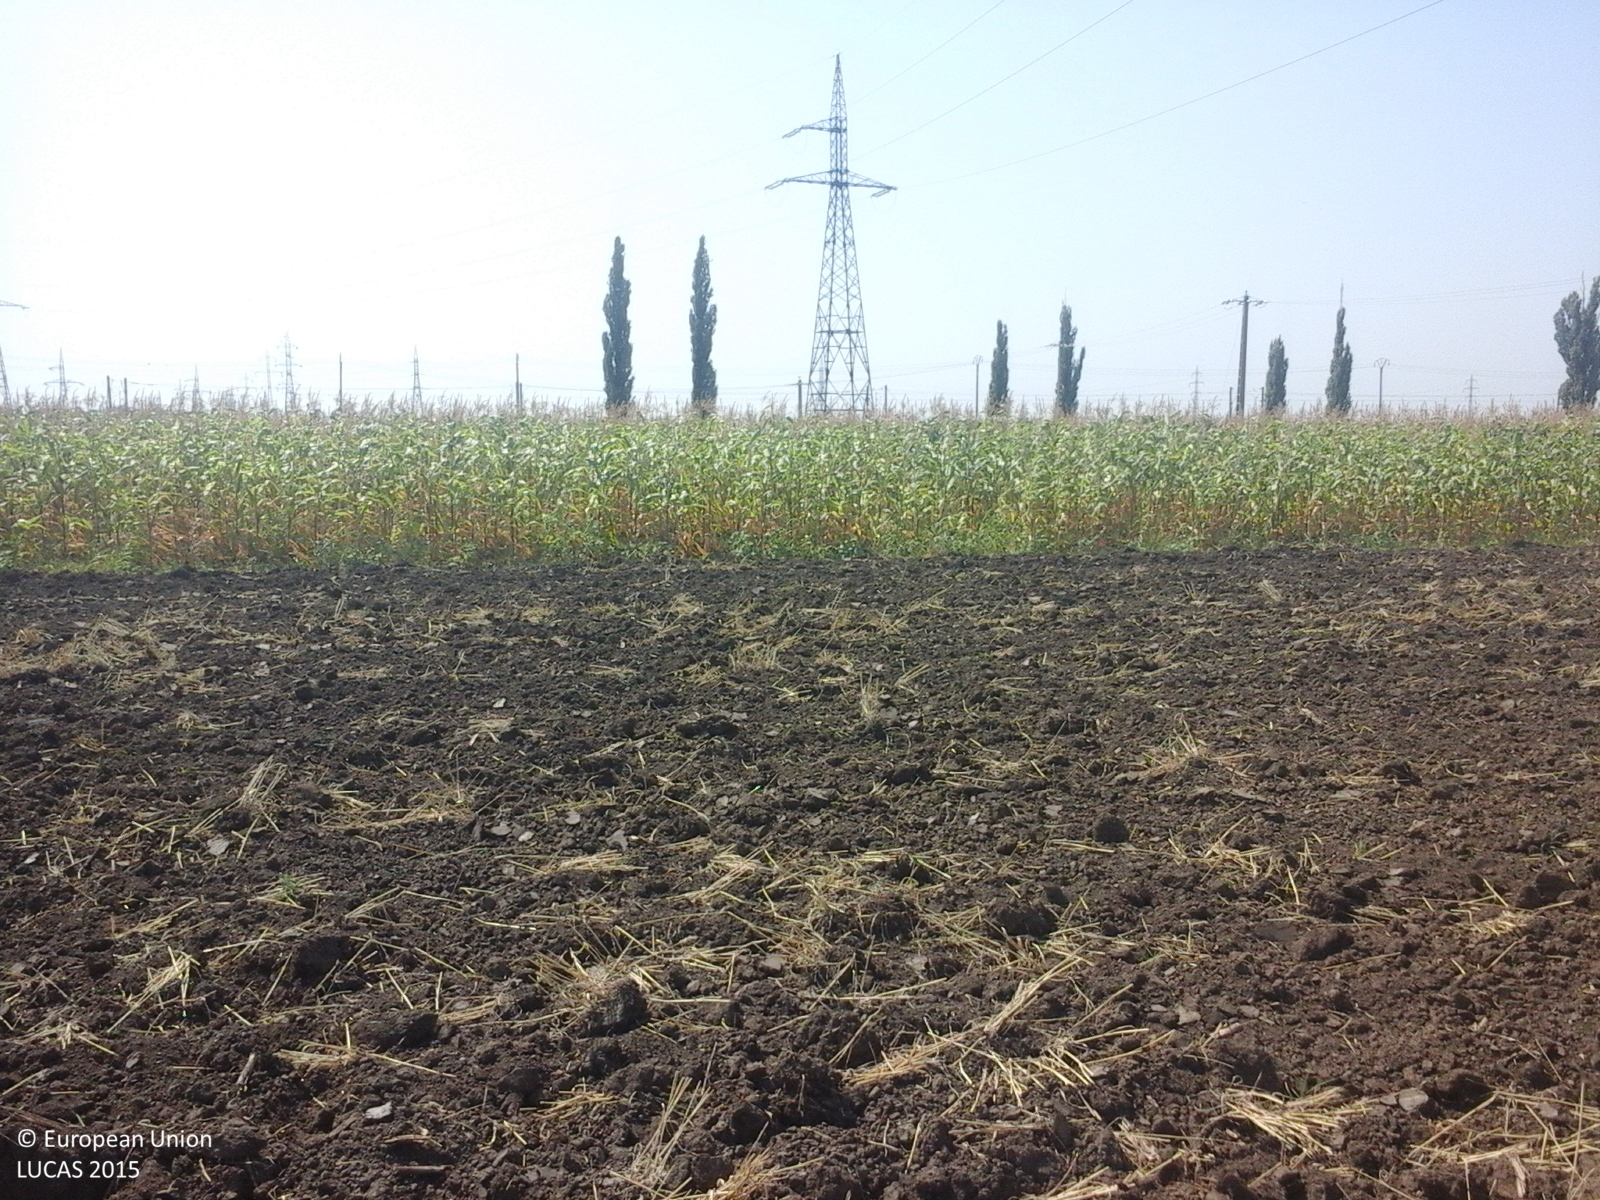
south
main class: Cropland
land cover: Common wheat
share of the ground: < 10 %
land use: Agriculture (excluding fallow land and kitchen gardens)
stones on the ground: < 10 %
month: August
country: RO
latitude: 45.0917
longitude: 27.3098
